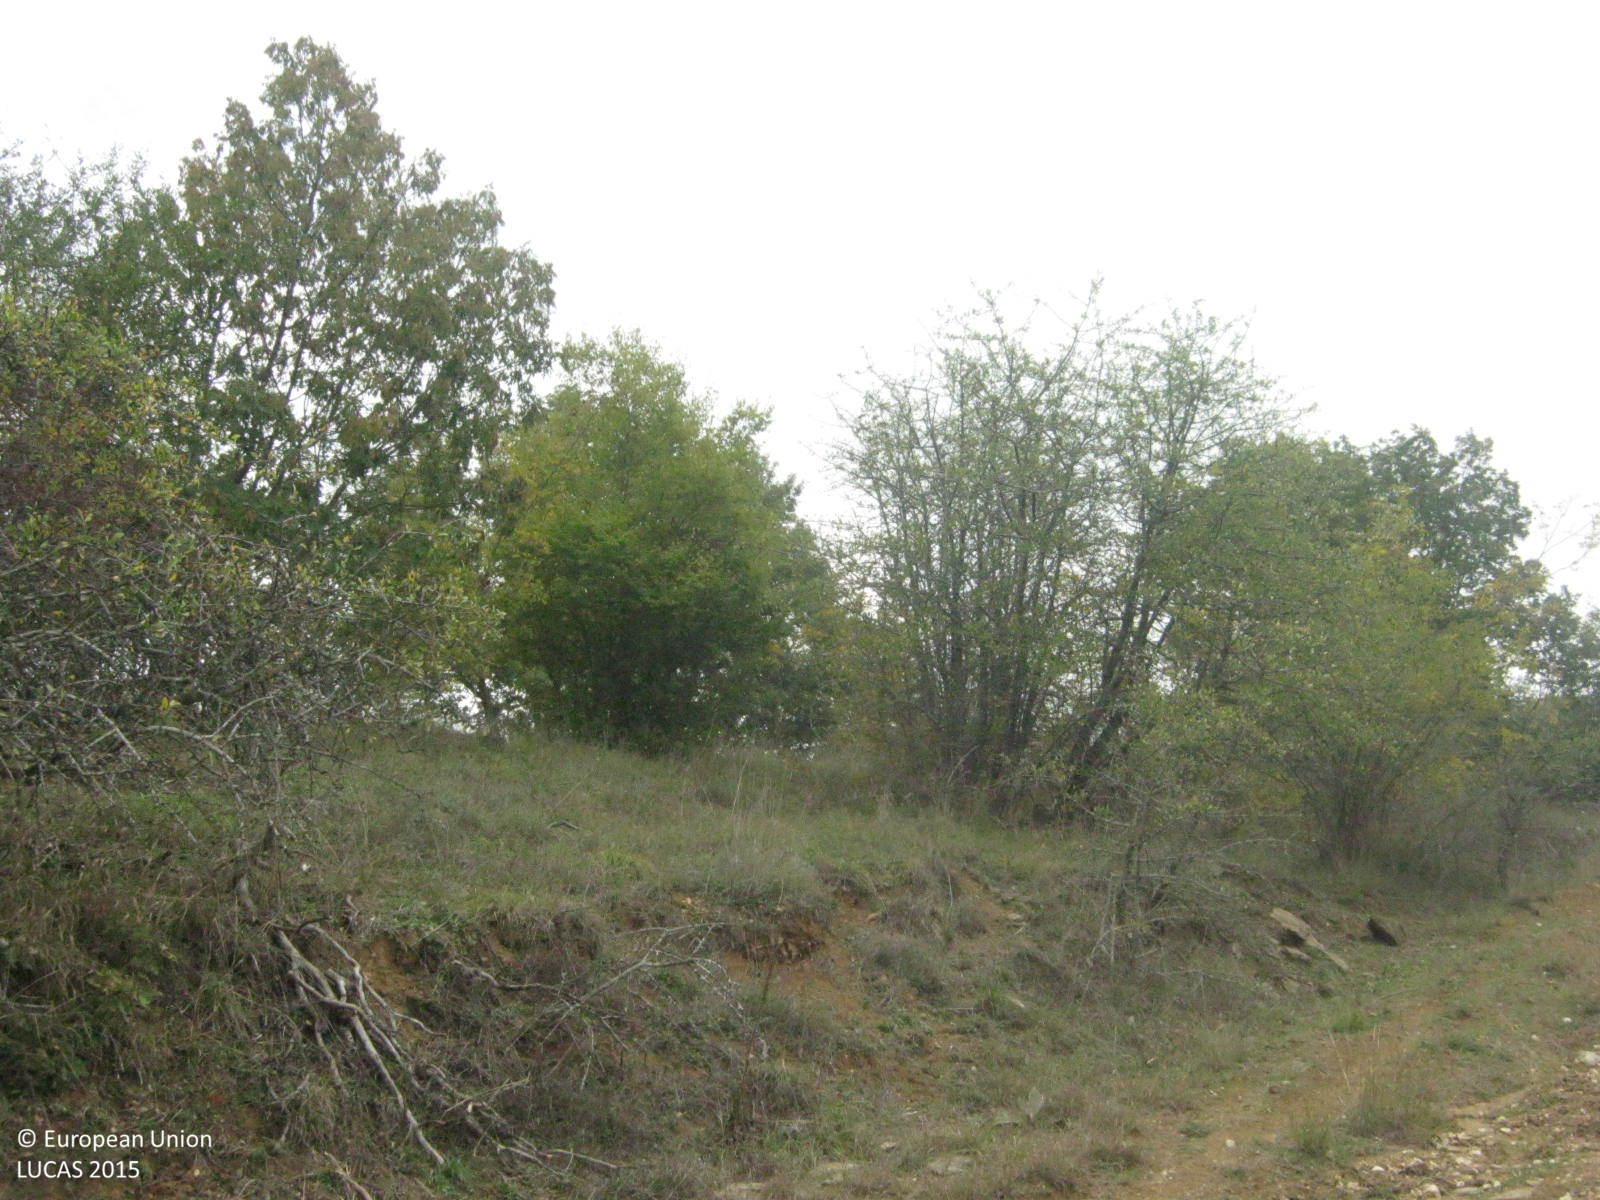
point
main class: Woodland
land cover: Broadleaved woodland
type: thermophilous deciduous forest
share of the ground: > 75 %
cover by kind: broadleaved forest trees 75 %, unconsolidated bare surface 20 %, shrubs 5 %
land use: Forestry
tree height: > 5 m
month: October
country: GR
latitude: 41.0009
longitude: 23.0545
